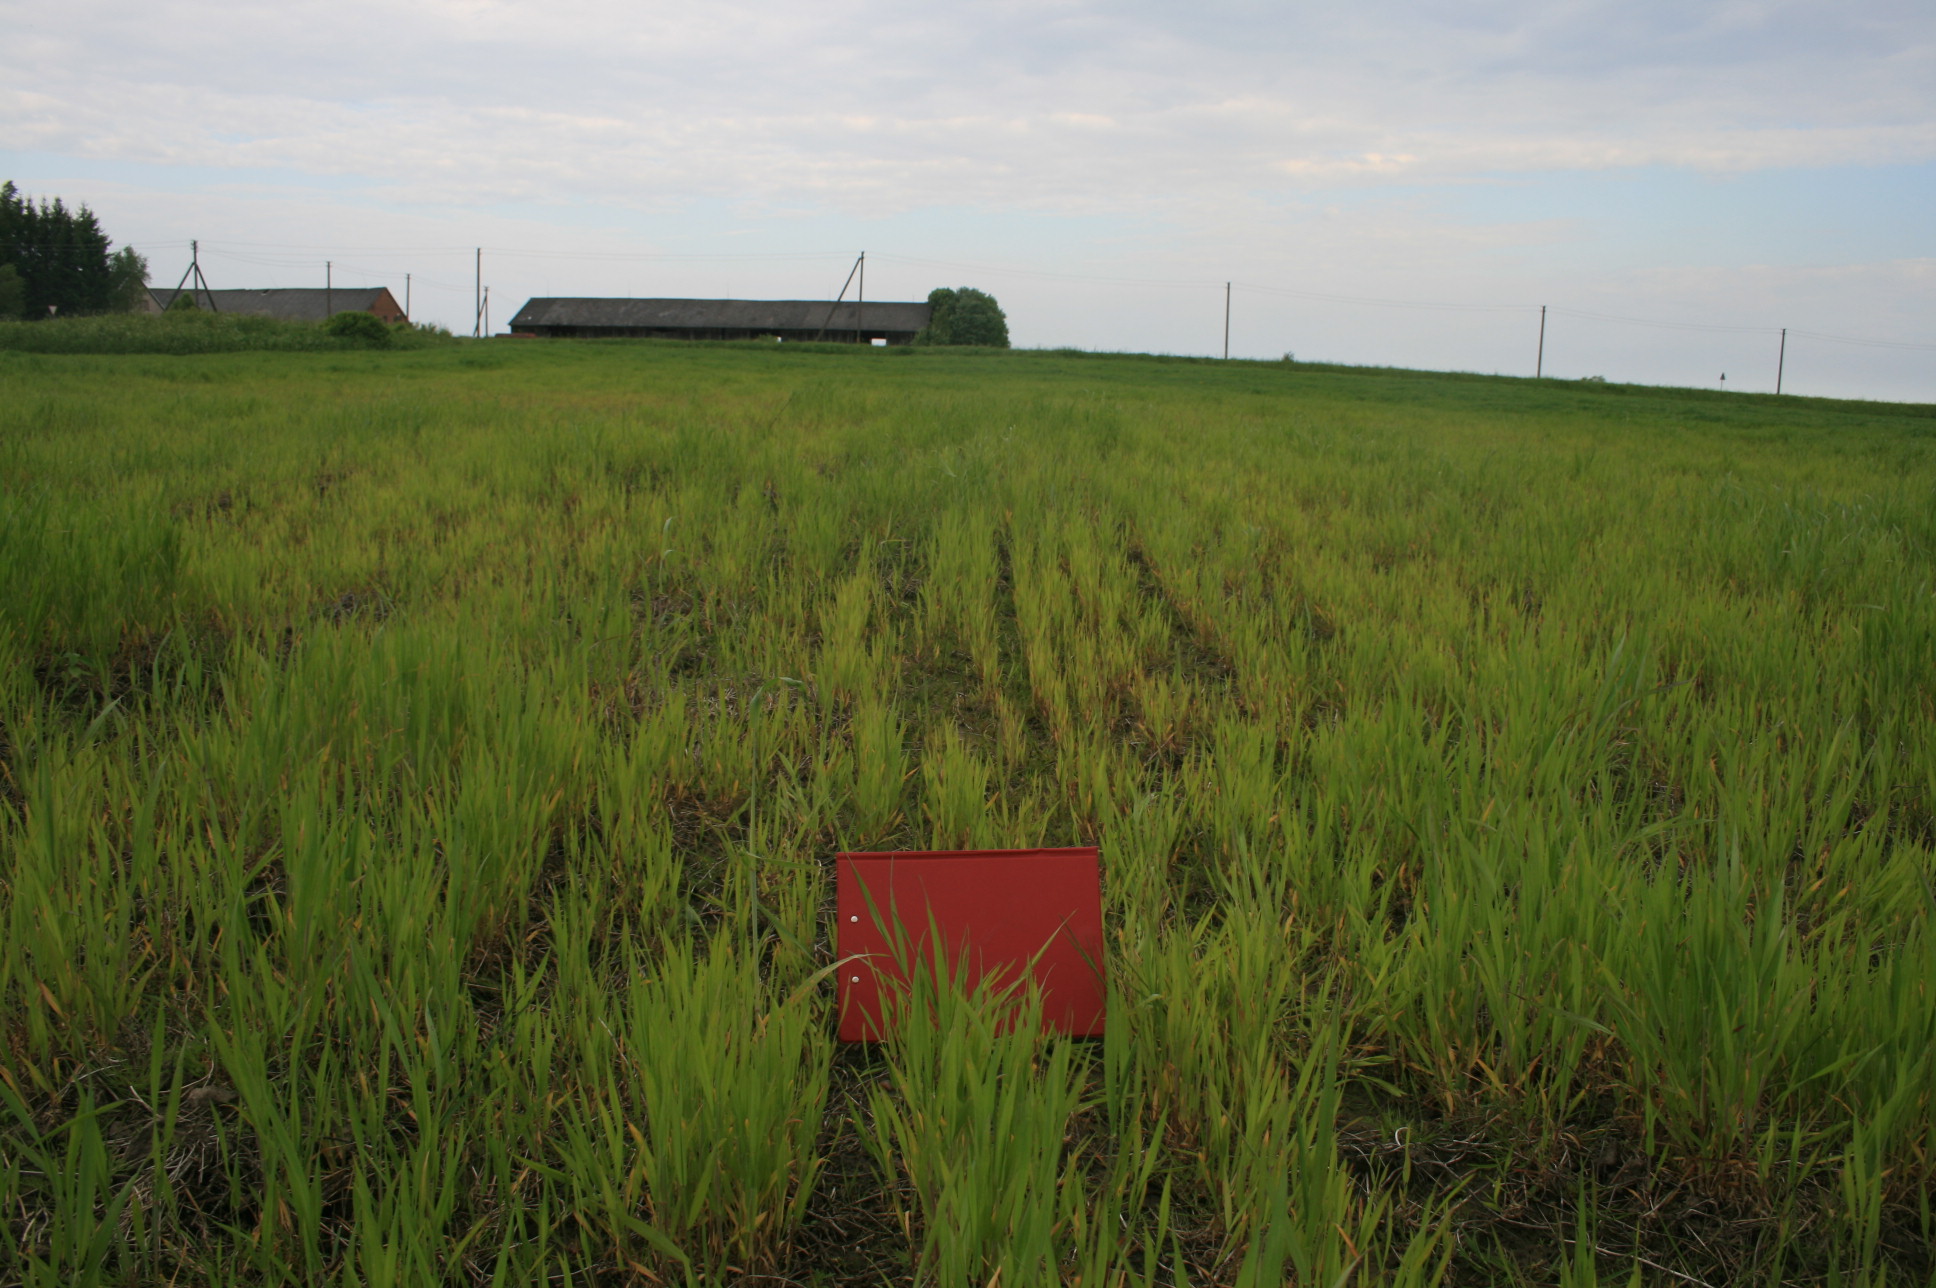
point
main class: Cropland
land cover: Common wheat
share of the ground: > 75 %
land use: Agriculture (excluding fallow land and kitchen gardens)
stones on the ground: < 10 %
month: May
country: LT
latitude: 55.8364
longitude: 21.6551
